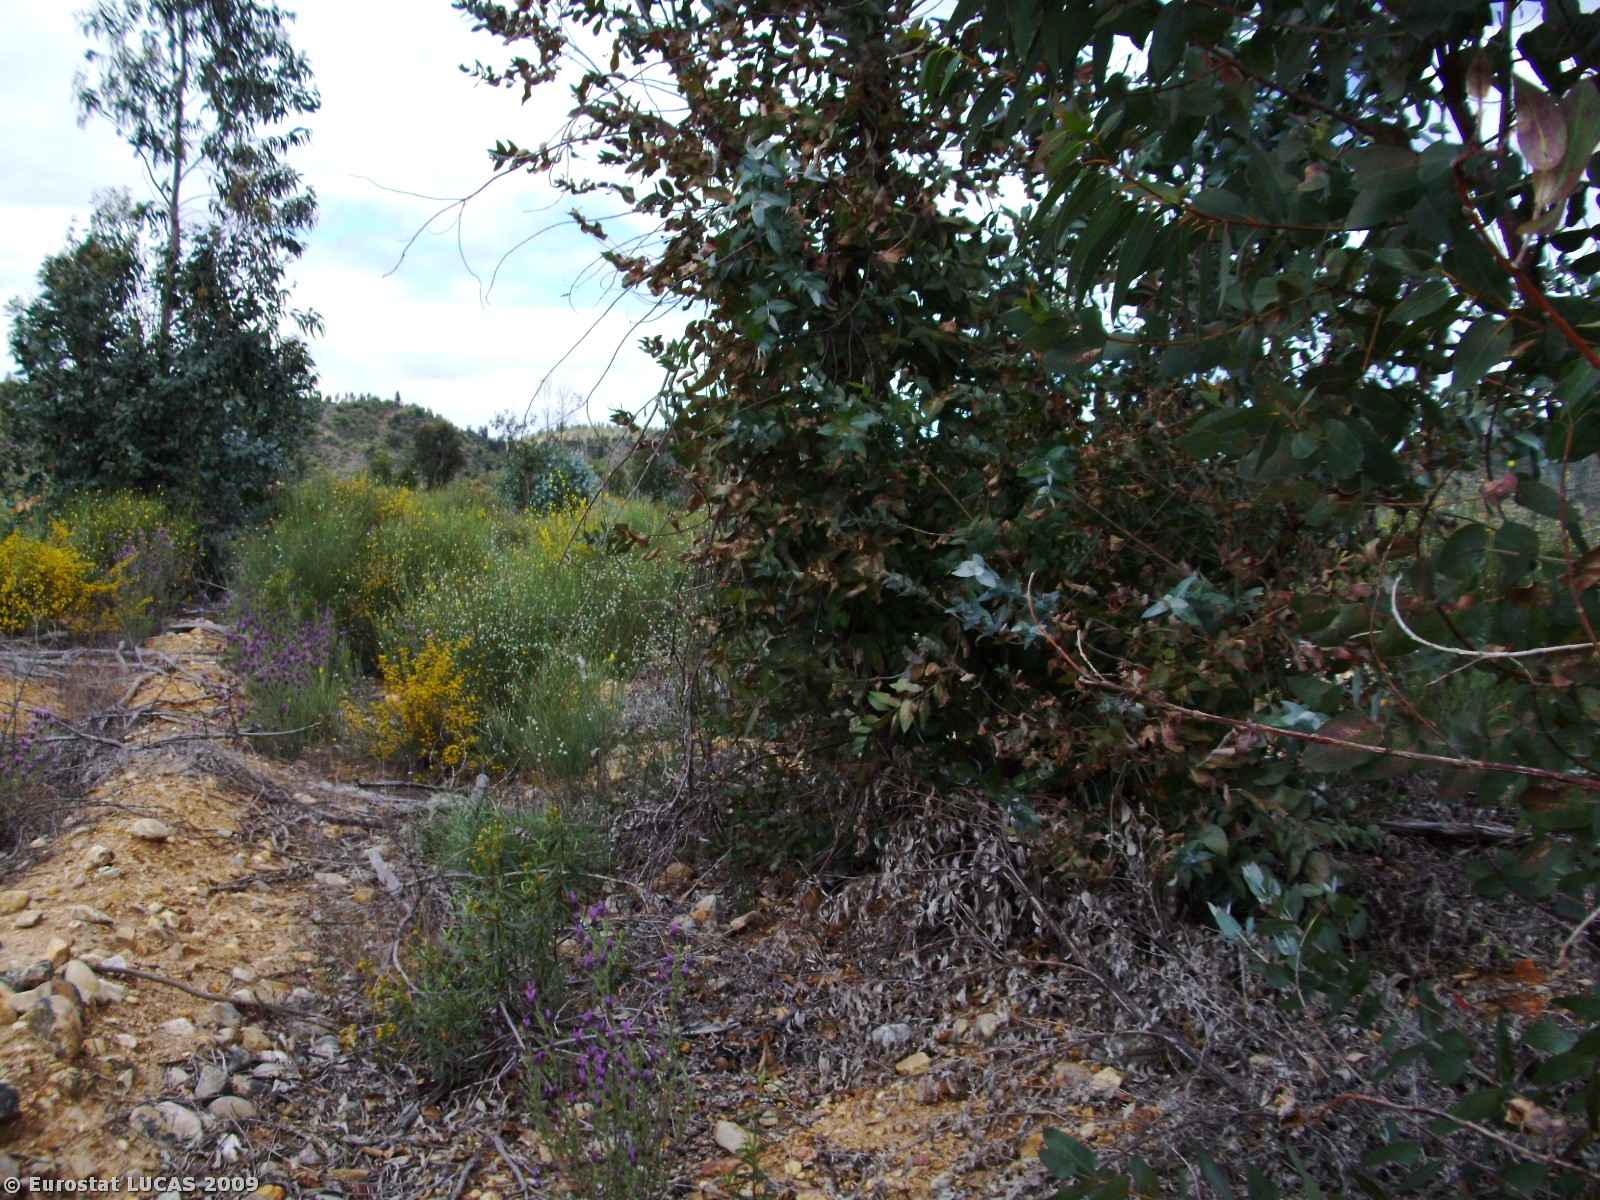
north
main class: Woodland
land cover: Broadleaved woodland
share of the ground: > 75 %
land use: Forestry
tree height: > 5 m
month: April
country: PT
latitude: 39.7814
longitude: -7.4359
